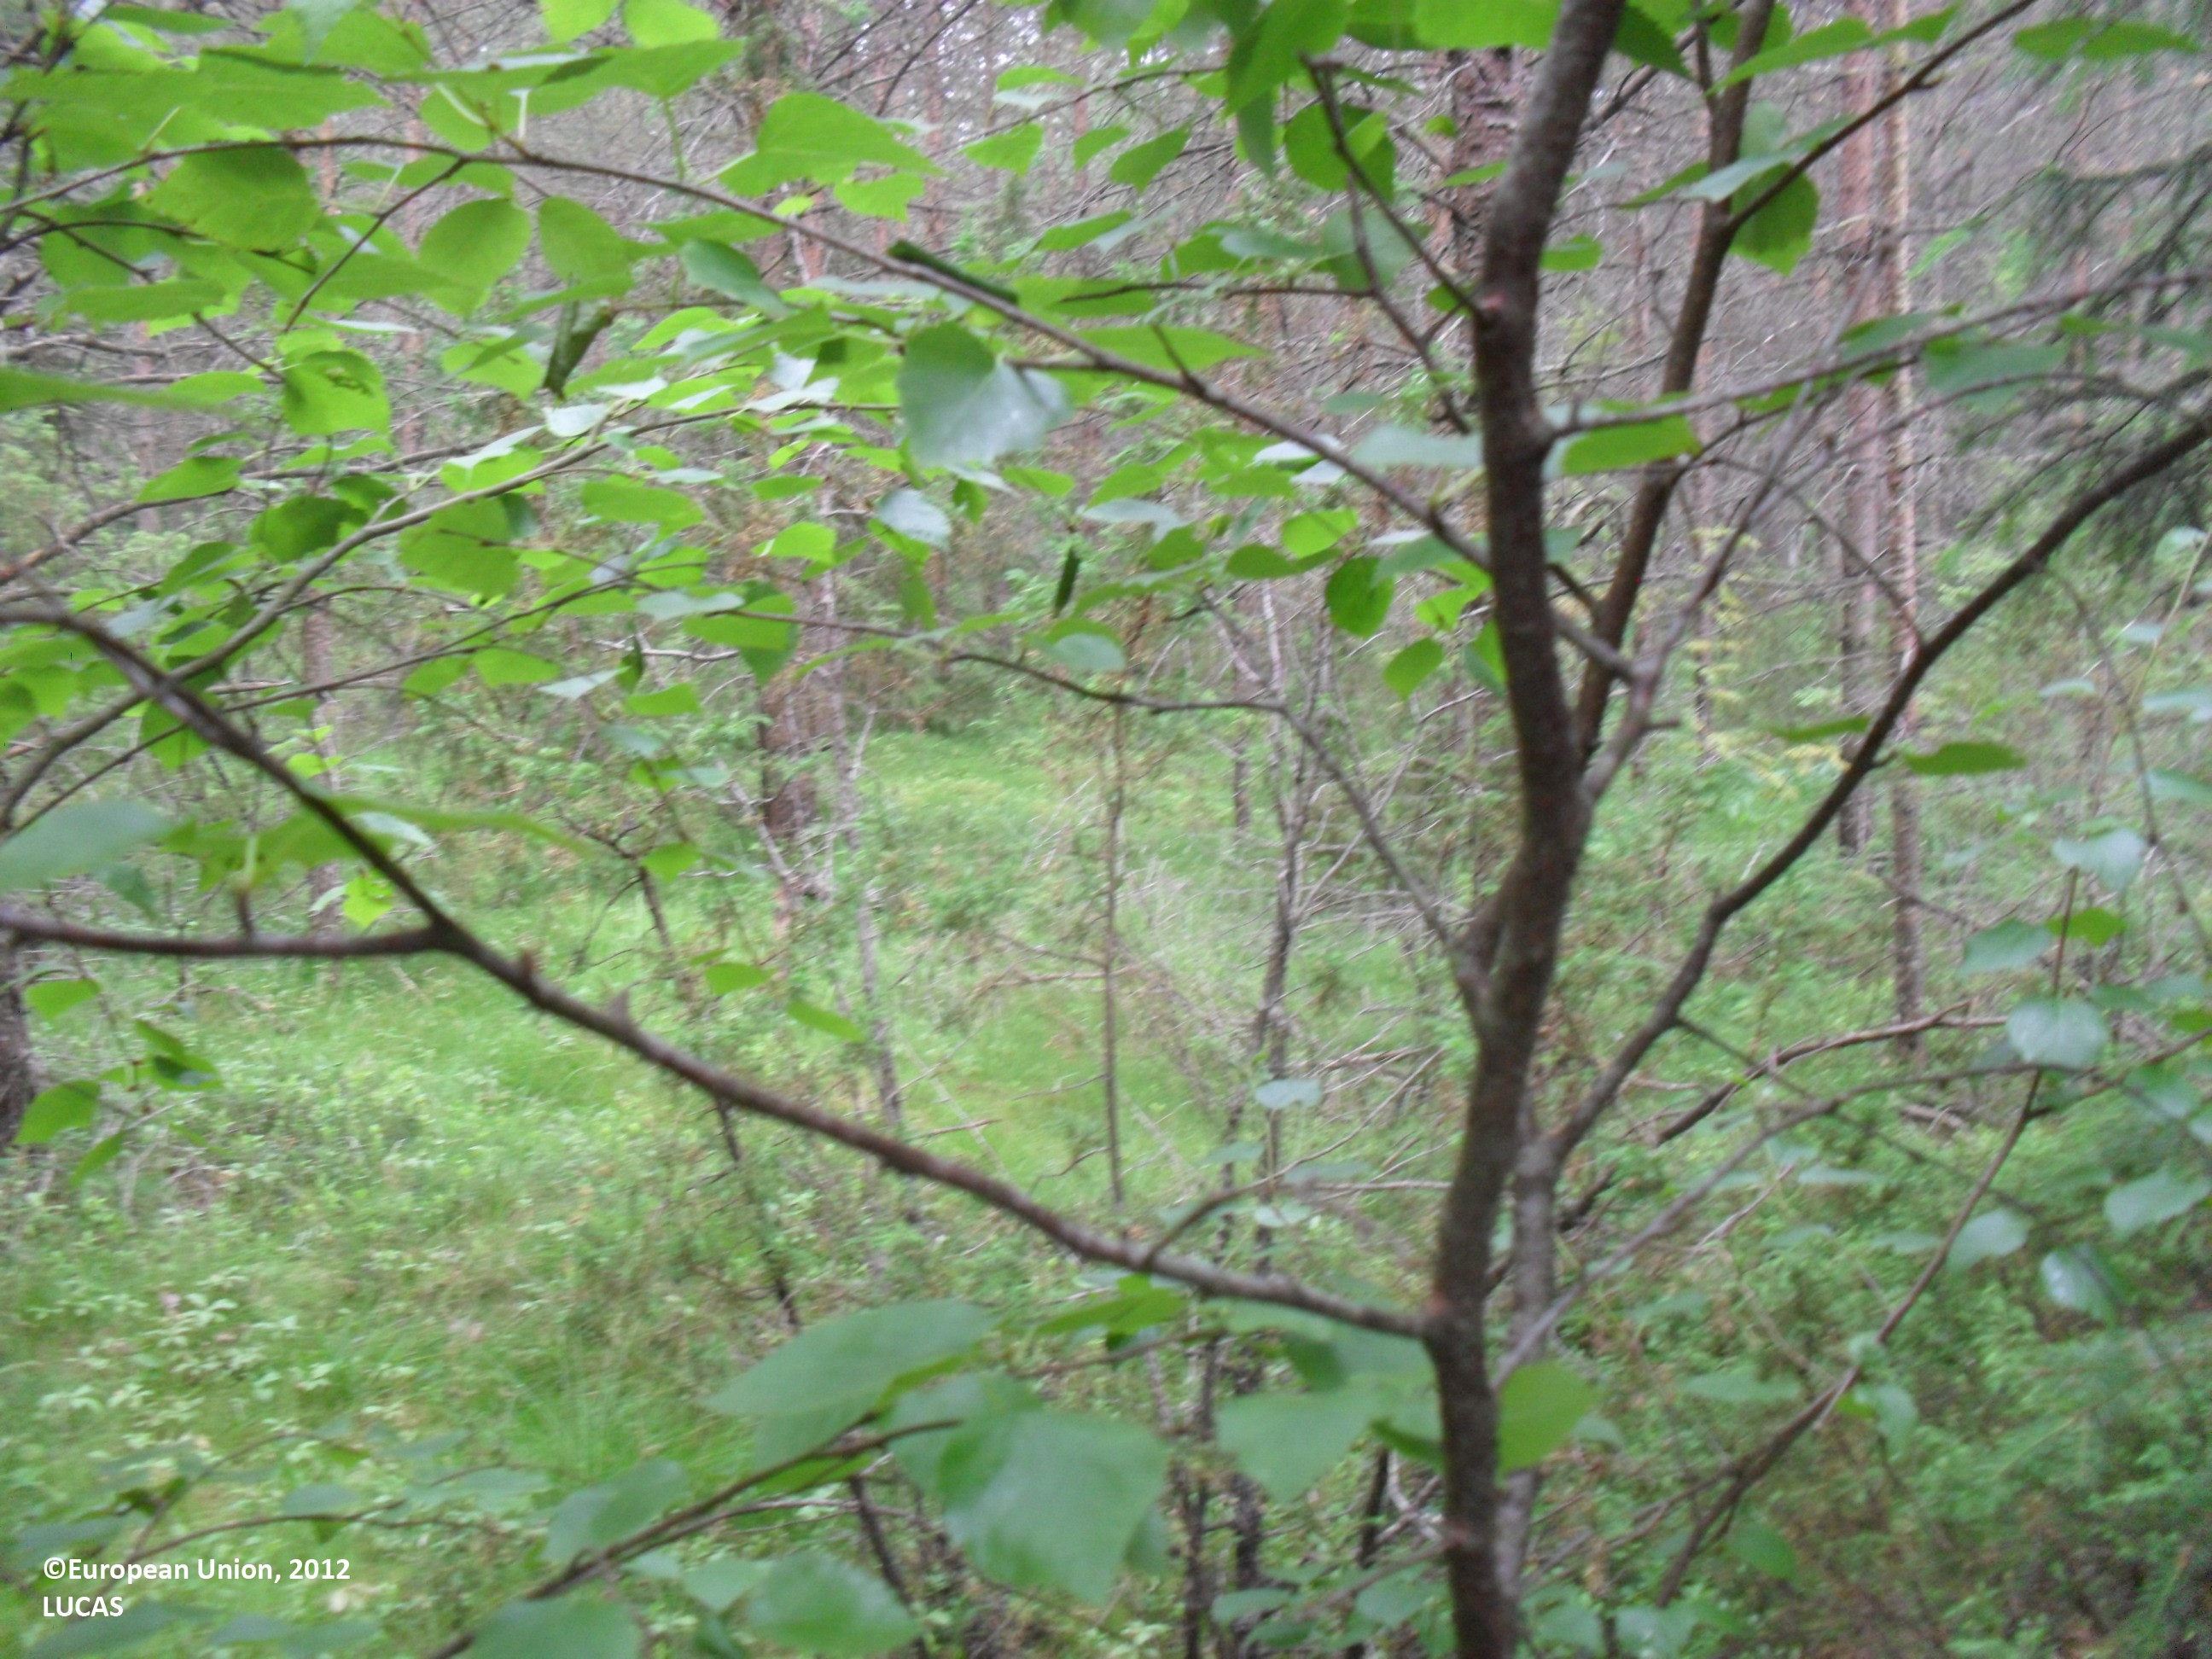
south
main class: Woodland
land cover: Pine dominated mixed woodland
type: boreal forest
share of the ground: 50 - 75 %
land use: Forestry
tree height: > 5 m
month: July
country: FI
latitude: 63.5832
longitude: 23.6627
